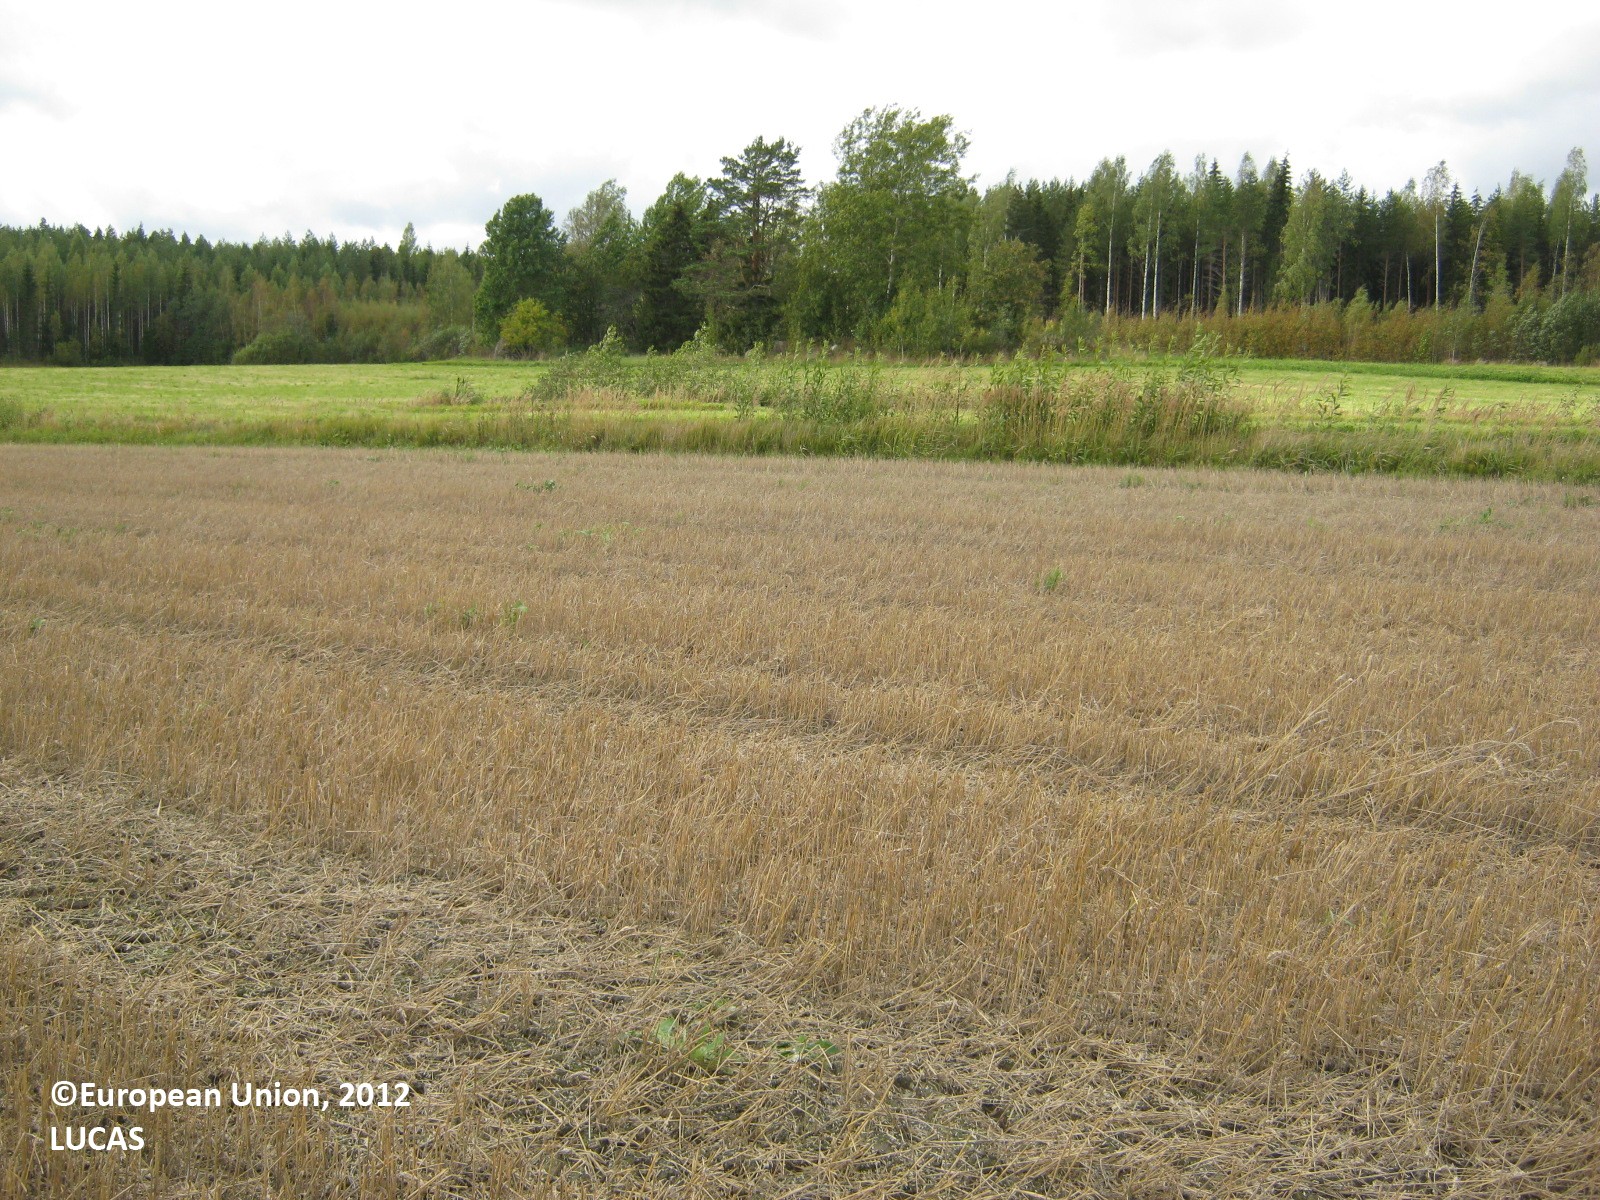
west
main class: Cropland
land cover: Common wheat
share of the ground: > 75 %
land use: Agriculture (excluding fallow land and kitchen gardens)
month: September
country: FI
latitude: 60.6454
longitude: 27.8063
